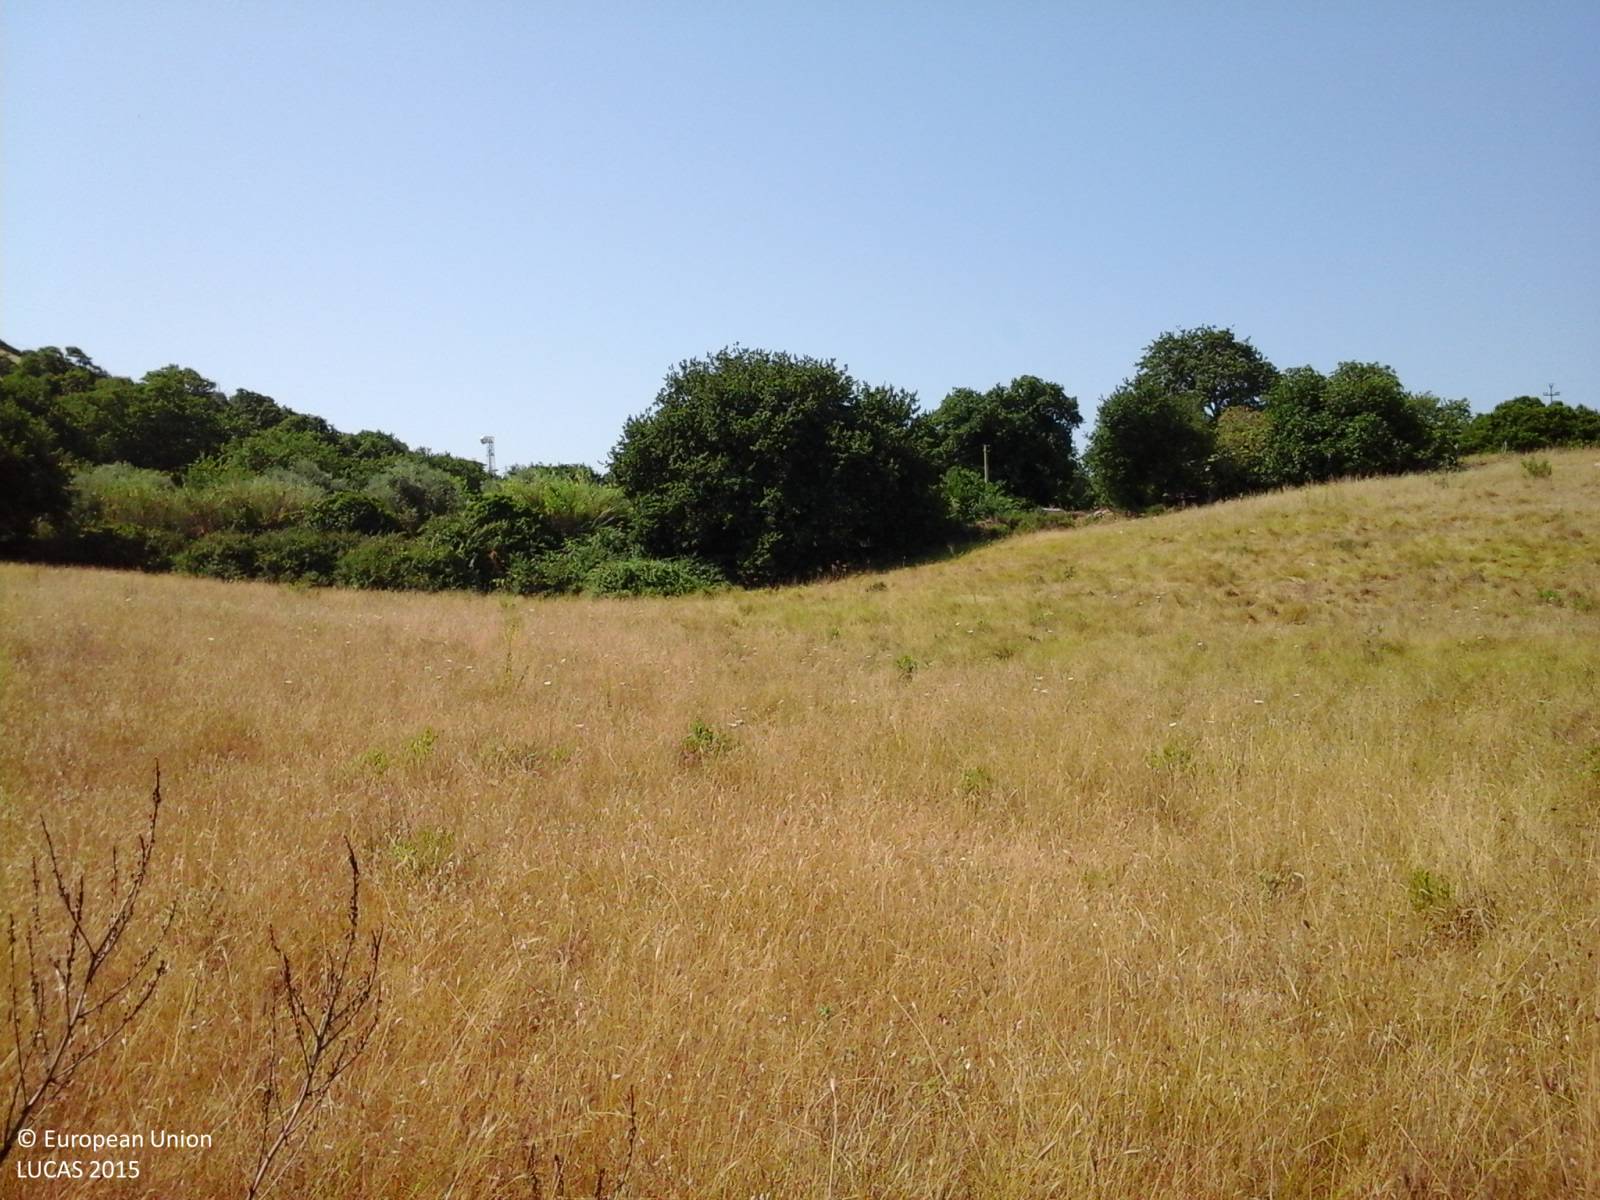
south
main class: Woodland
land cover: Broadleaved woodland
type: thermophilous deciduous forest
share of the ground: 25 - 50 %
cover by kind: broadleaved forest trees 90 %, herbaceous plants 10 %
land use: Semi-natural and natural areas not in use
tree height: > 5 m
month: July
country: IT
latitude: 40.7850
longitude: 8.8088
